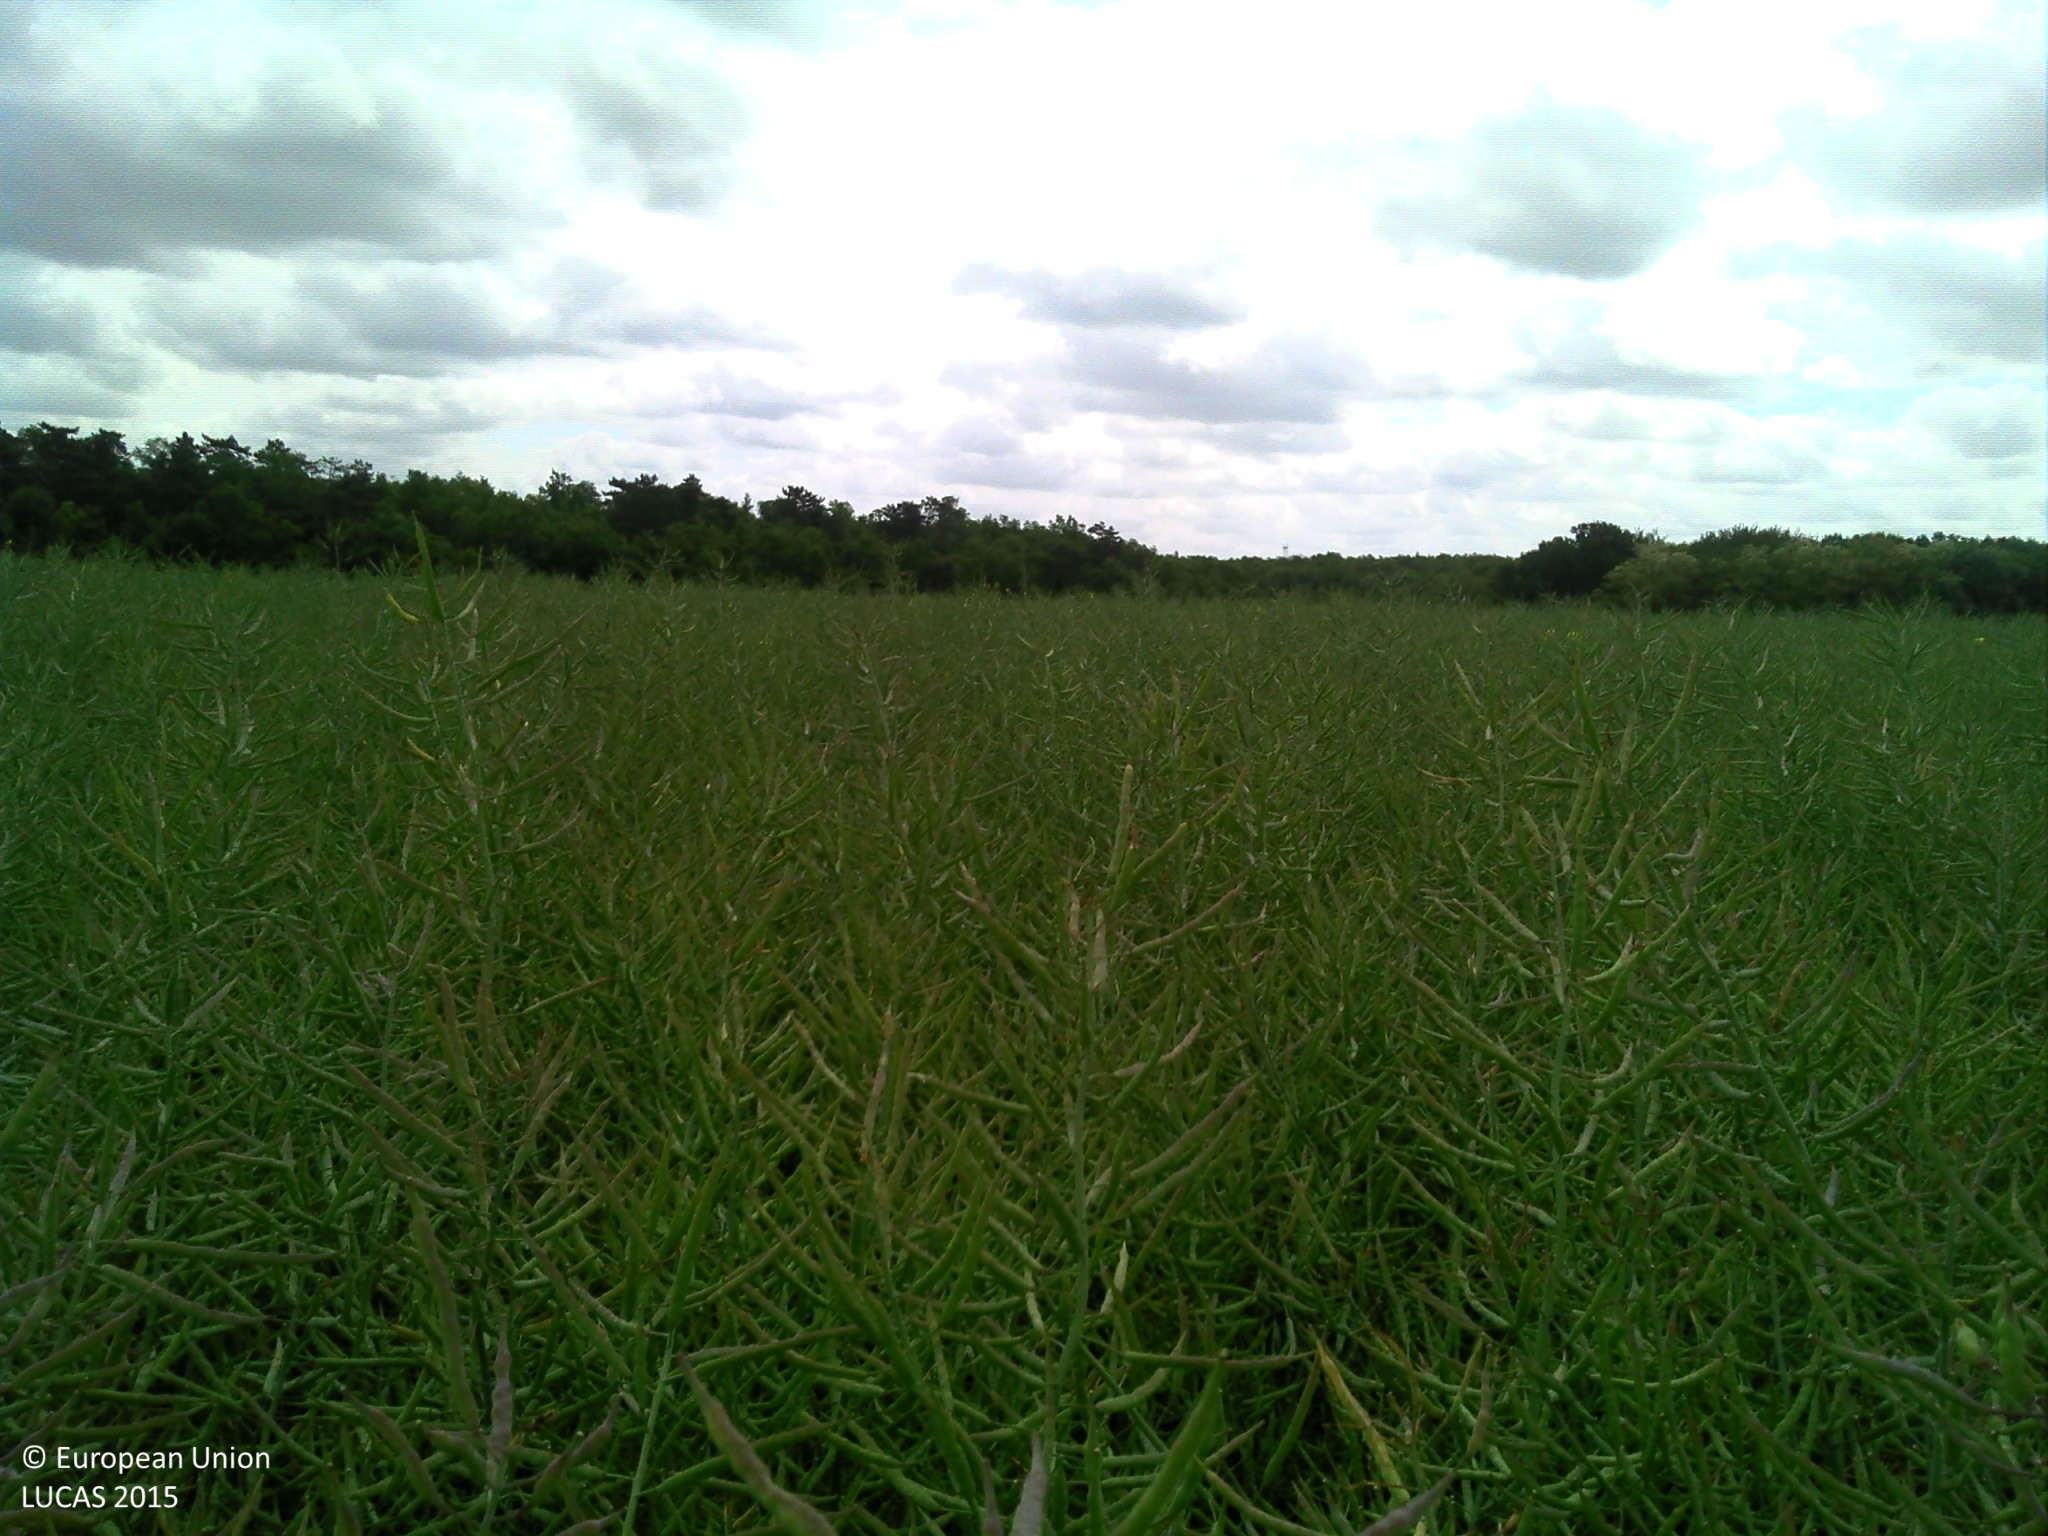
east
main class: Cropland
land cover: Rape and turnip rape
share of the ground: > 75 %
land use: Agriculture (excluding fallow land and kitchen gardens)
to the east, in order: Rape and turnip rape; Broadleaved woodland
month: June
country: FR
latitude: 48.3652
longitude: 1.9824
